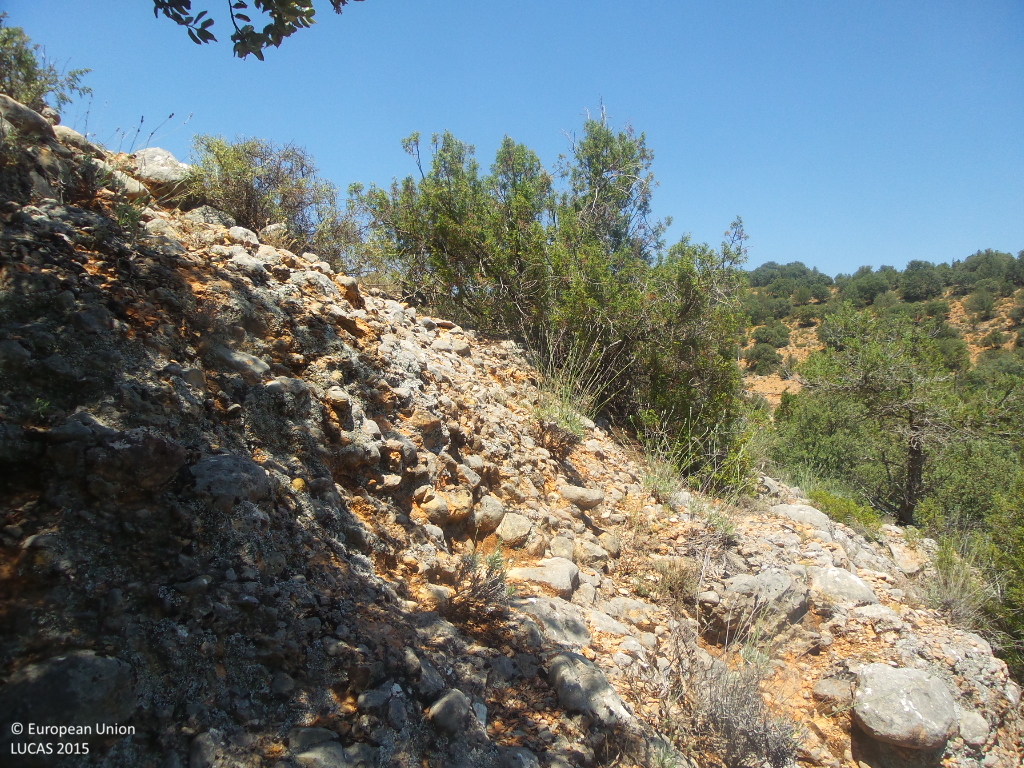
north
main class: Woodland
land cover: Other mixed woodland
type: broadleaved evergreen forest
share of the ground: 50 - 75 %
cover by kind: broadleaved forest trees 40 %, coniferous forest trees 20 %, shrubs 15 %, unconsolidated bare surface 15 %, herbaceous plants 5 %, consolidated bare surface 5 %
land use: Semi-natural and natural areas not in use
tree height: > 5 m
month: July
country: ES
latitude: 41.1323
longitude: -2.0223
